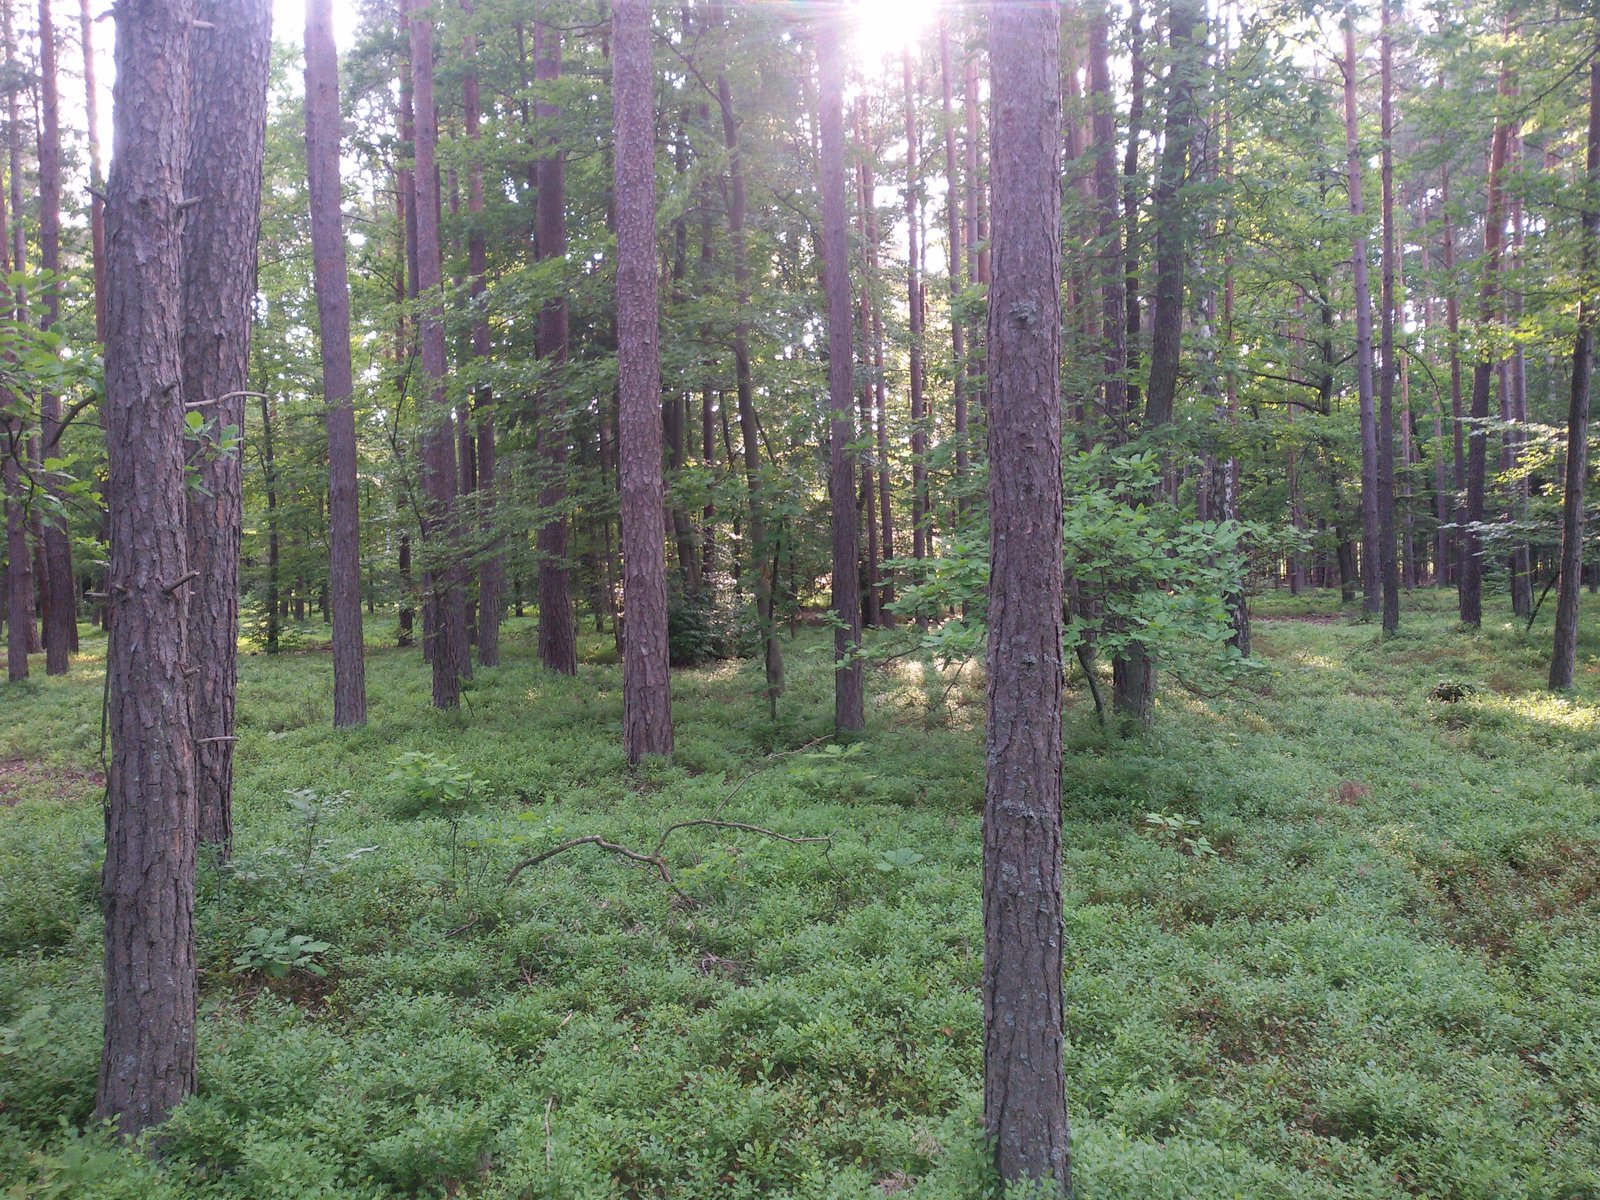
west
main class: Woodland
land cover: Pine dominated coniferous woodland
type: hemiboreal forest and nemoral coniferous forest and mixed broadleaved-coniferous forest
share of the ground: 25 - 50 %
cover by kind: coniferous forest trees 45 %, shrubs 30 %, herbaceous plants 20 %, lichens and mosses 5 %
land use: Forestry
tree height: > 5 m
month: June
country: PL
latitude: 50.1859
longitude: 21.6347
